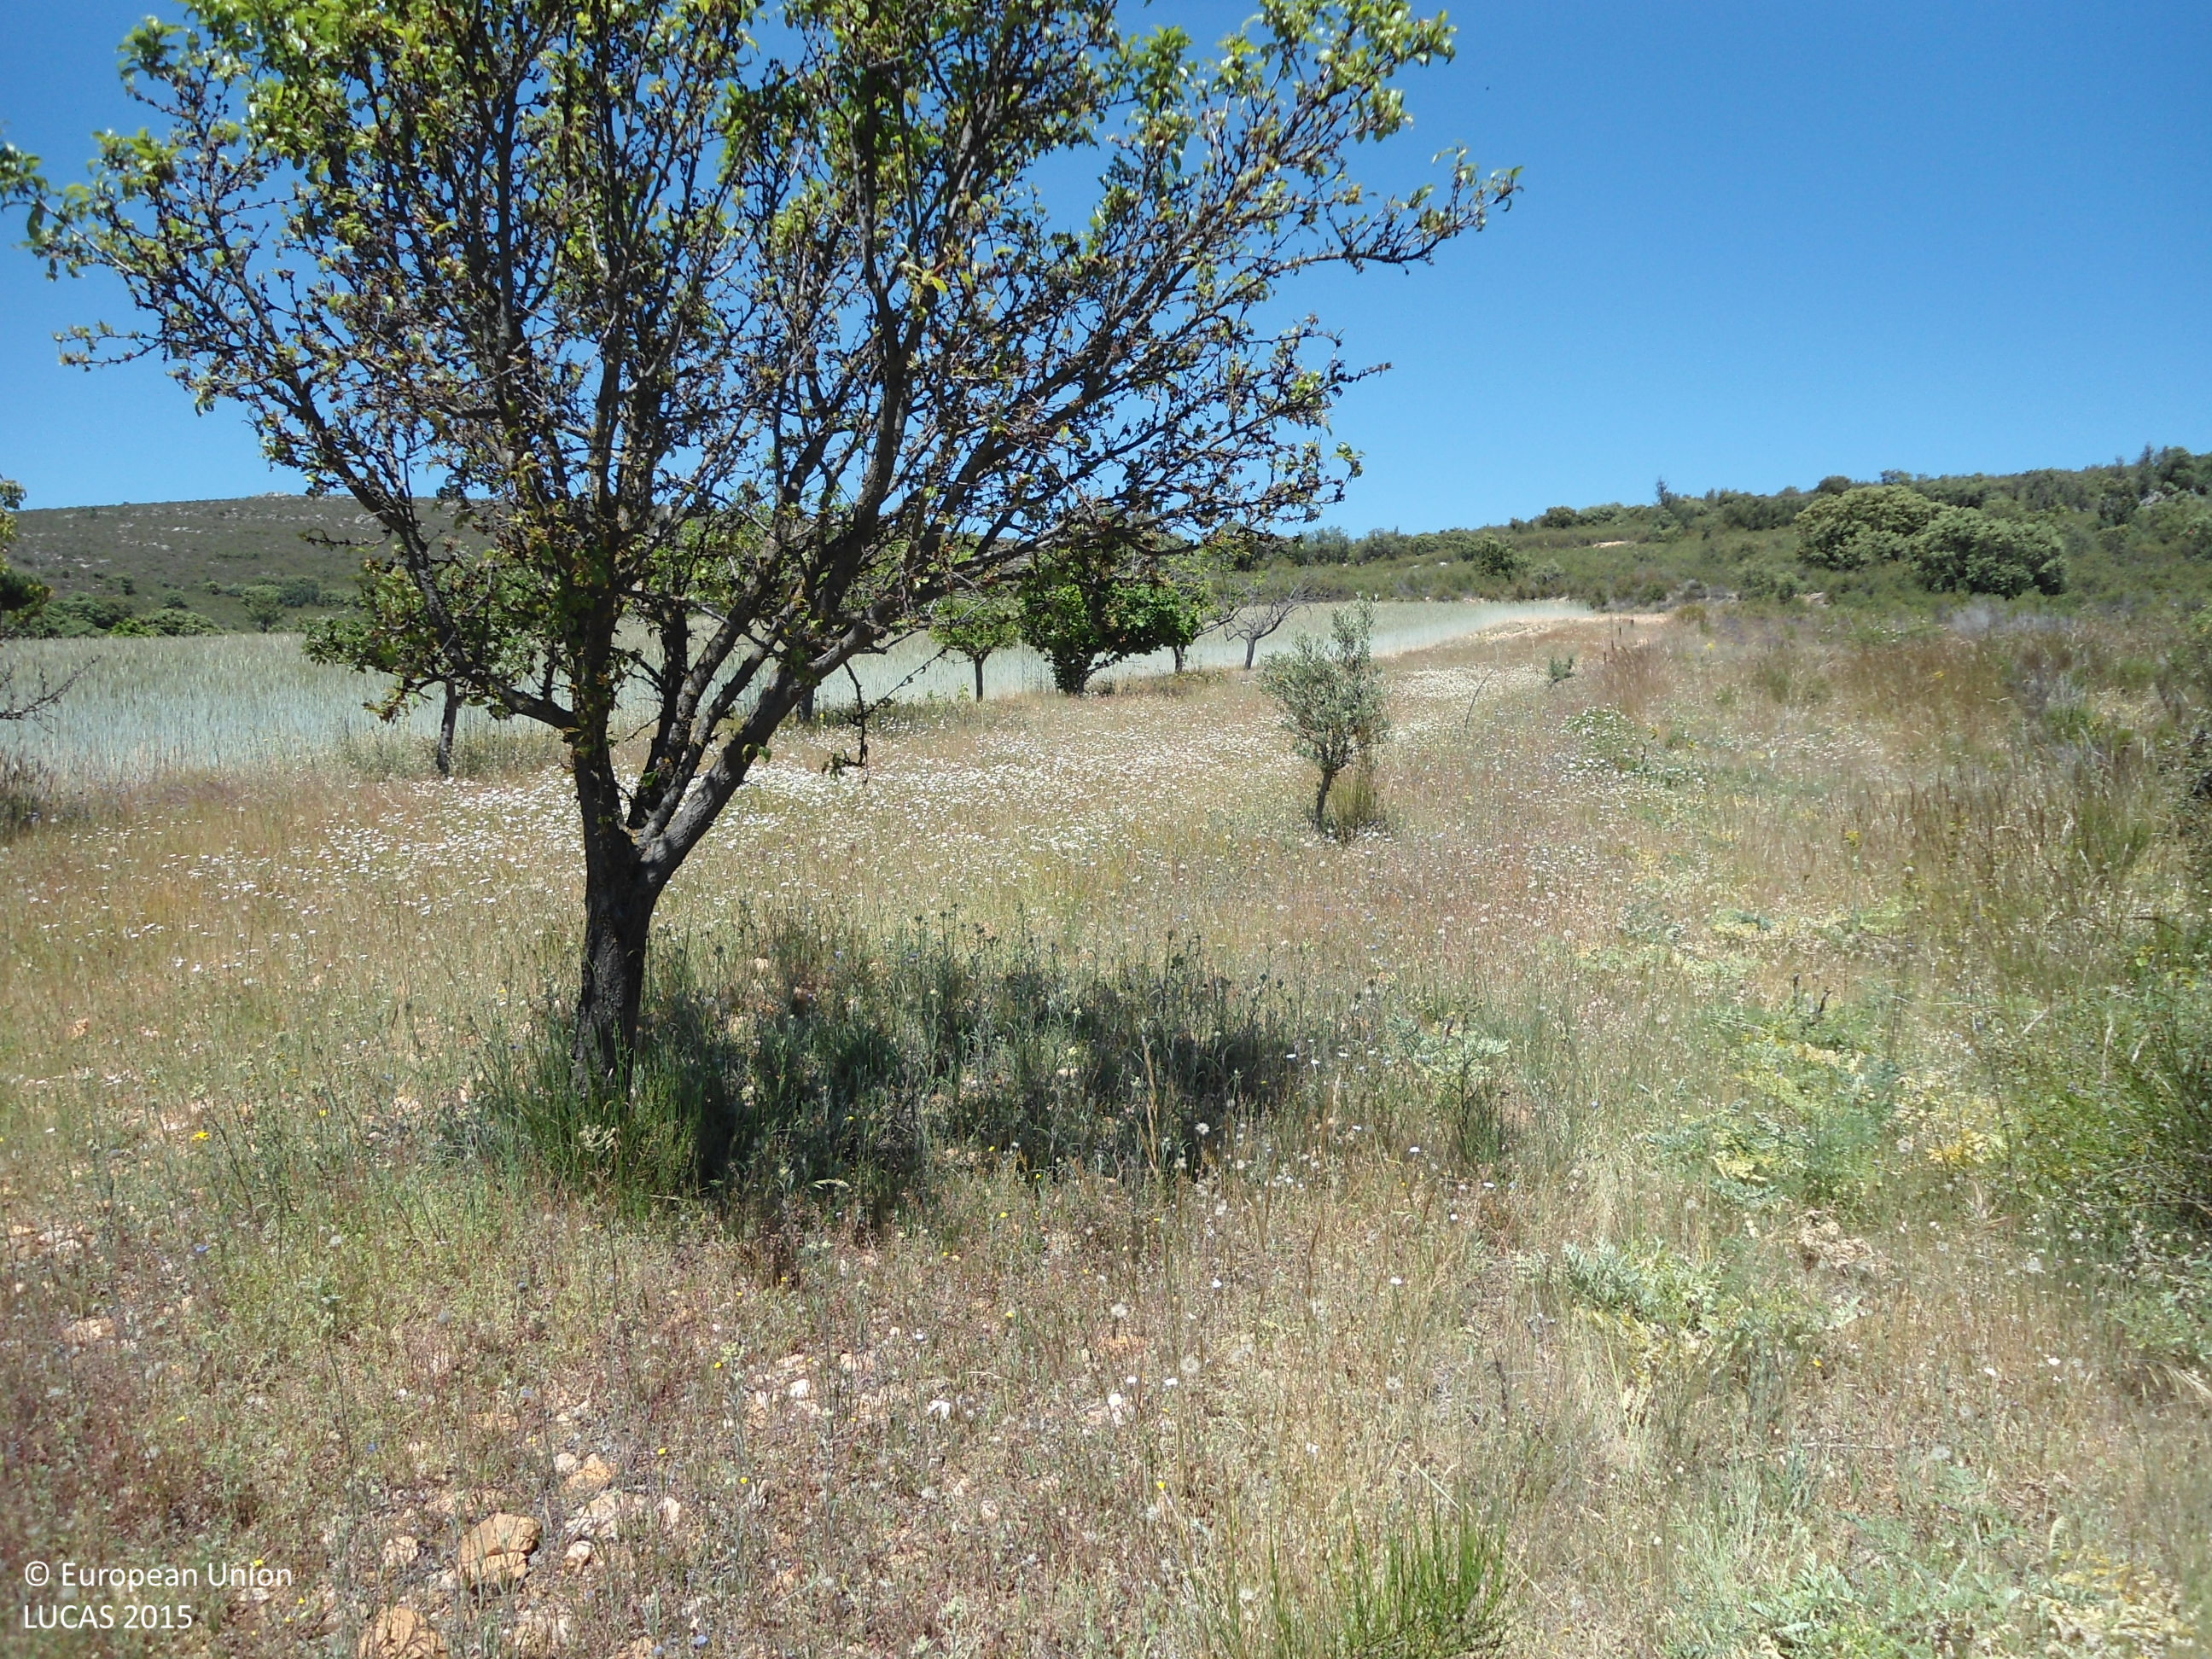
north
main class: Shrubland
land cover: Shrubland without tree cover
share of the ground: > 75 %
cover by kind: shrubs 80 %, herbaceous plants 20 %
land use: Semi-natural and natural areas not in use
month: May
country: ES
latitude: 42.1033
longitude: -6.0262
